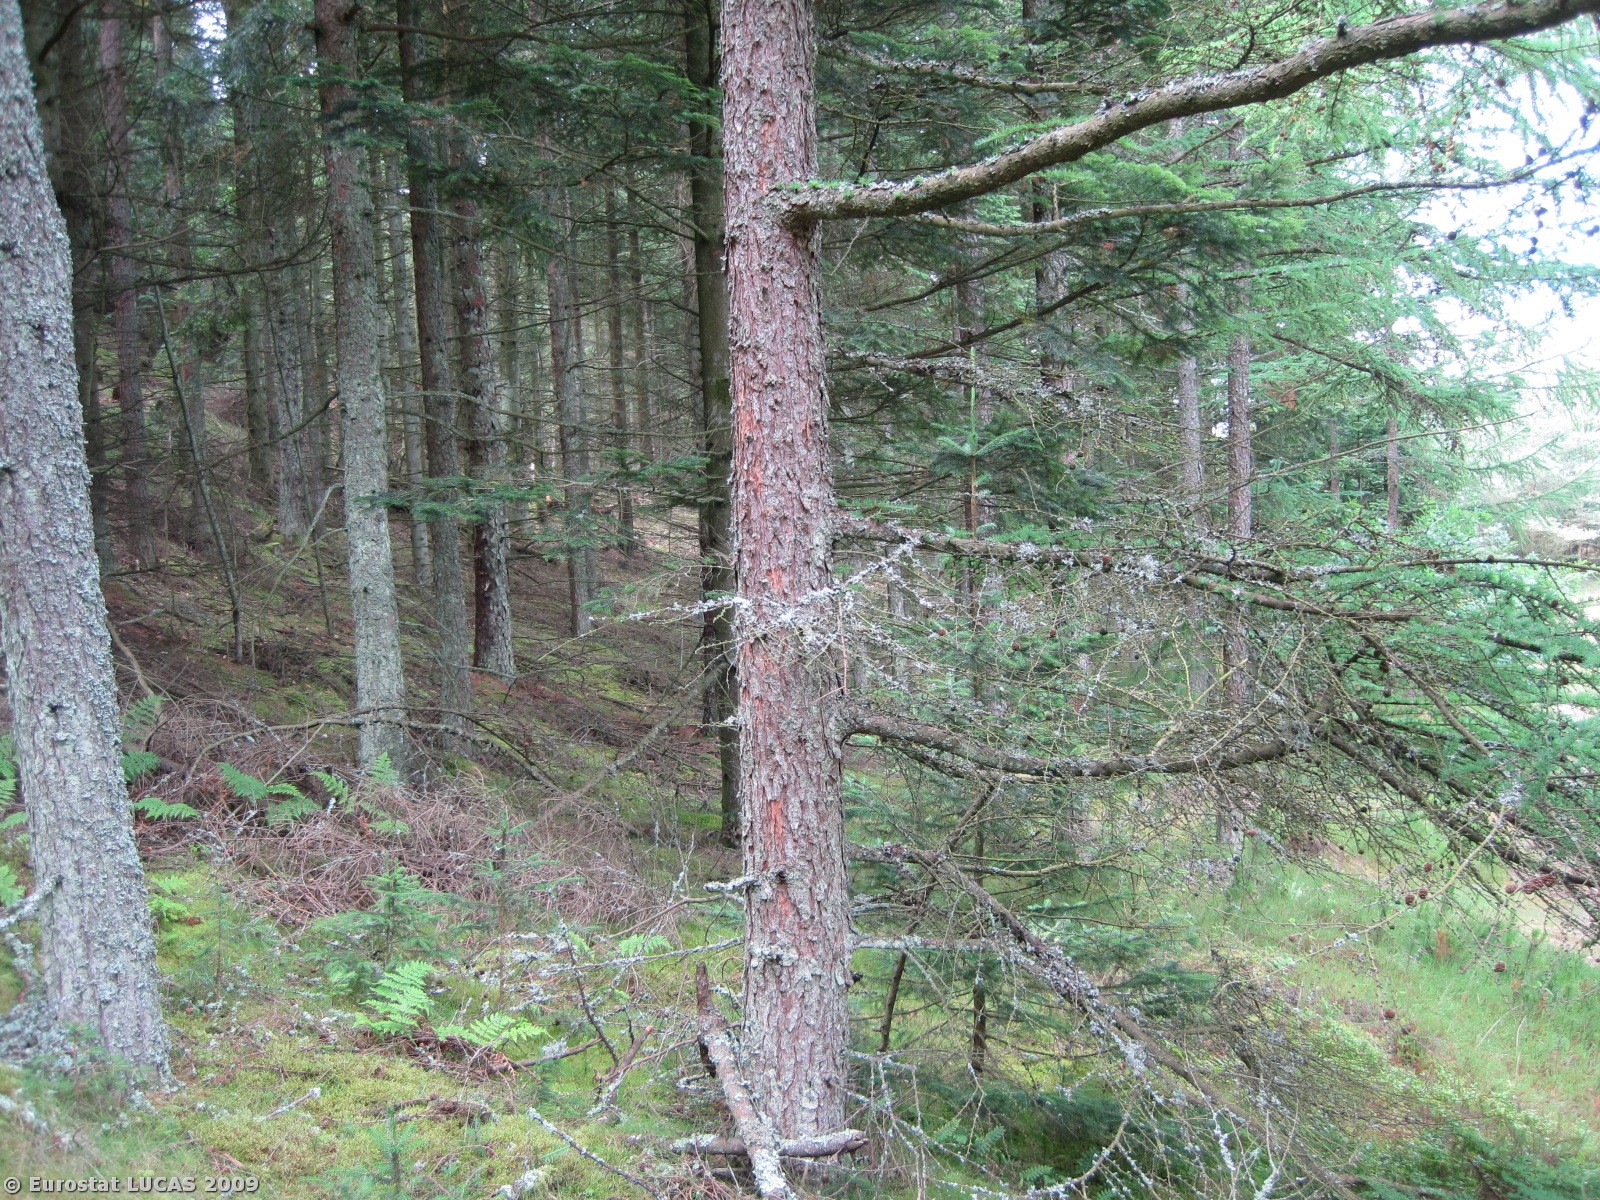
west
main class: Woodland
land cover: Coniferous woodland
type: plantations and self-sown exotic forest
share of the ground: 50 - 75 %
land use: Forestry
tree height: > 5 m
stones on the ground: < 10 %
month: July
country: DK
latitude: 57.0825
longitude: 8.9621
